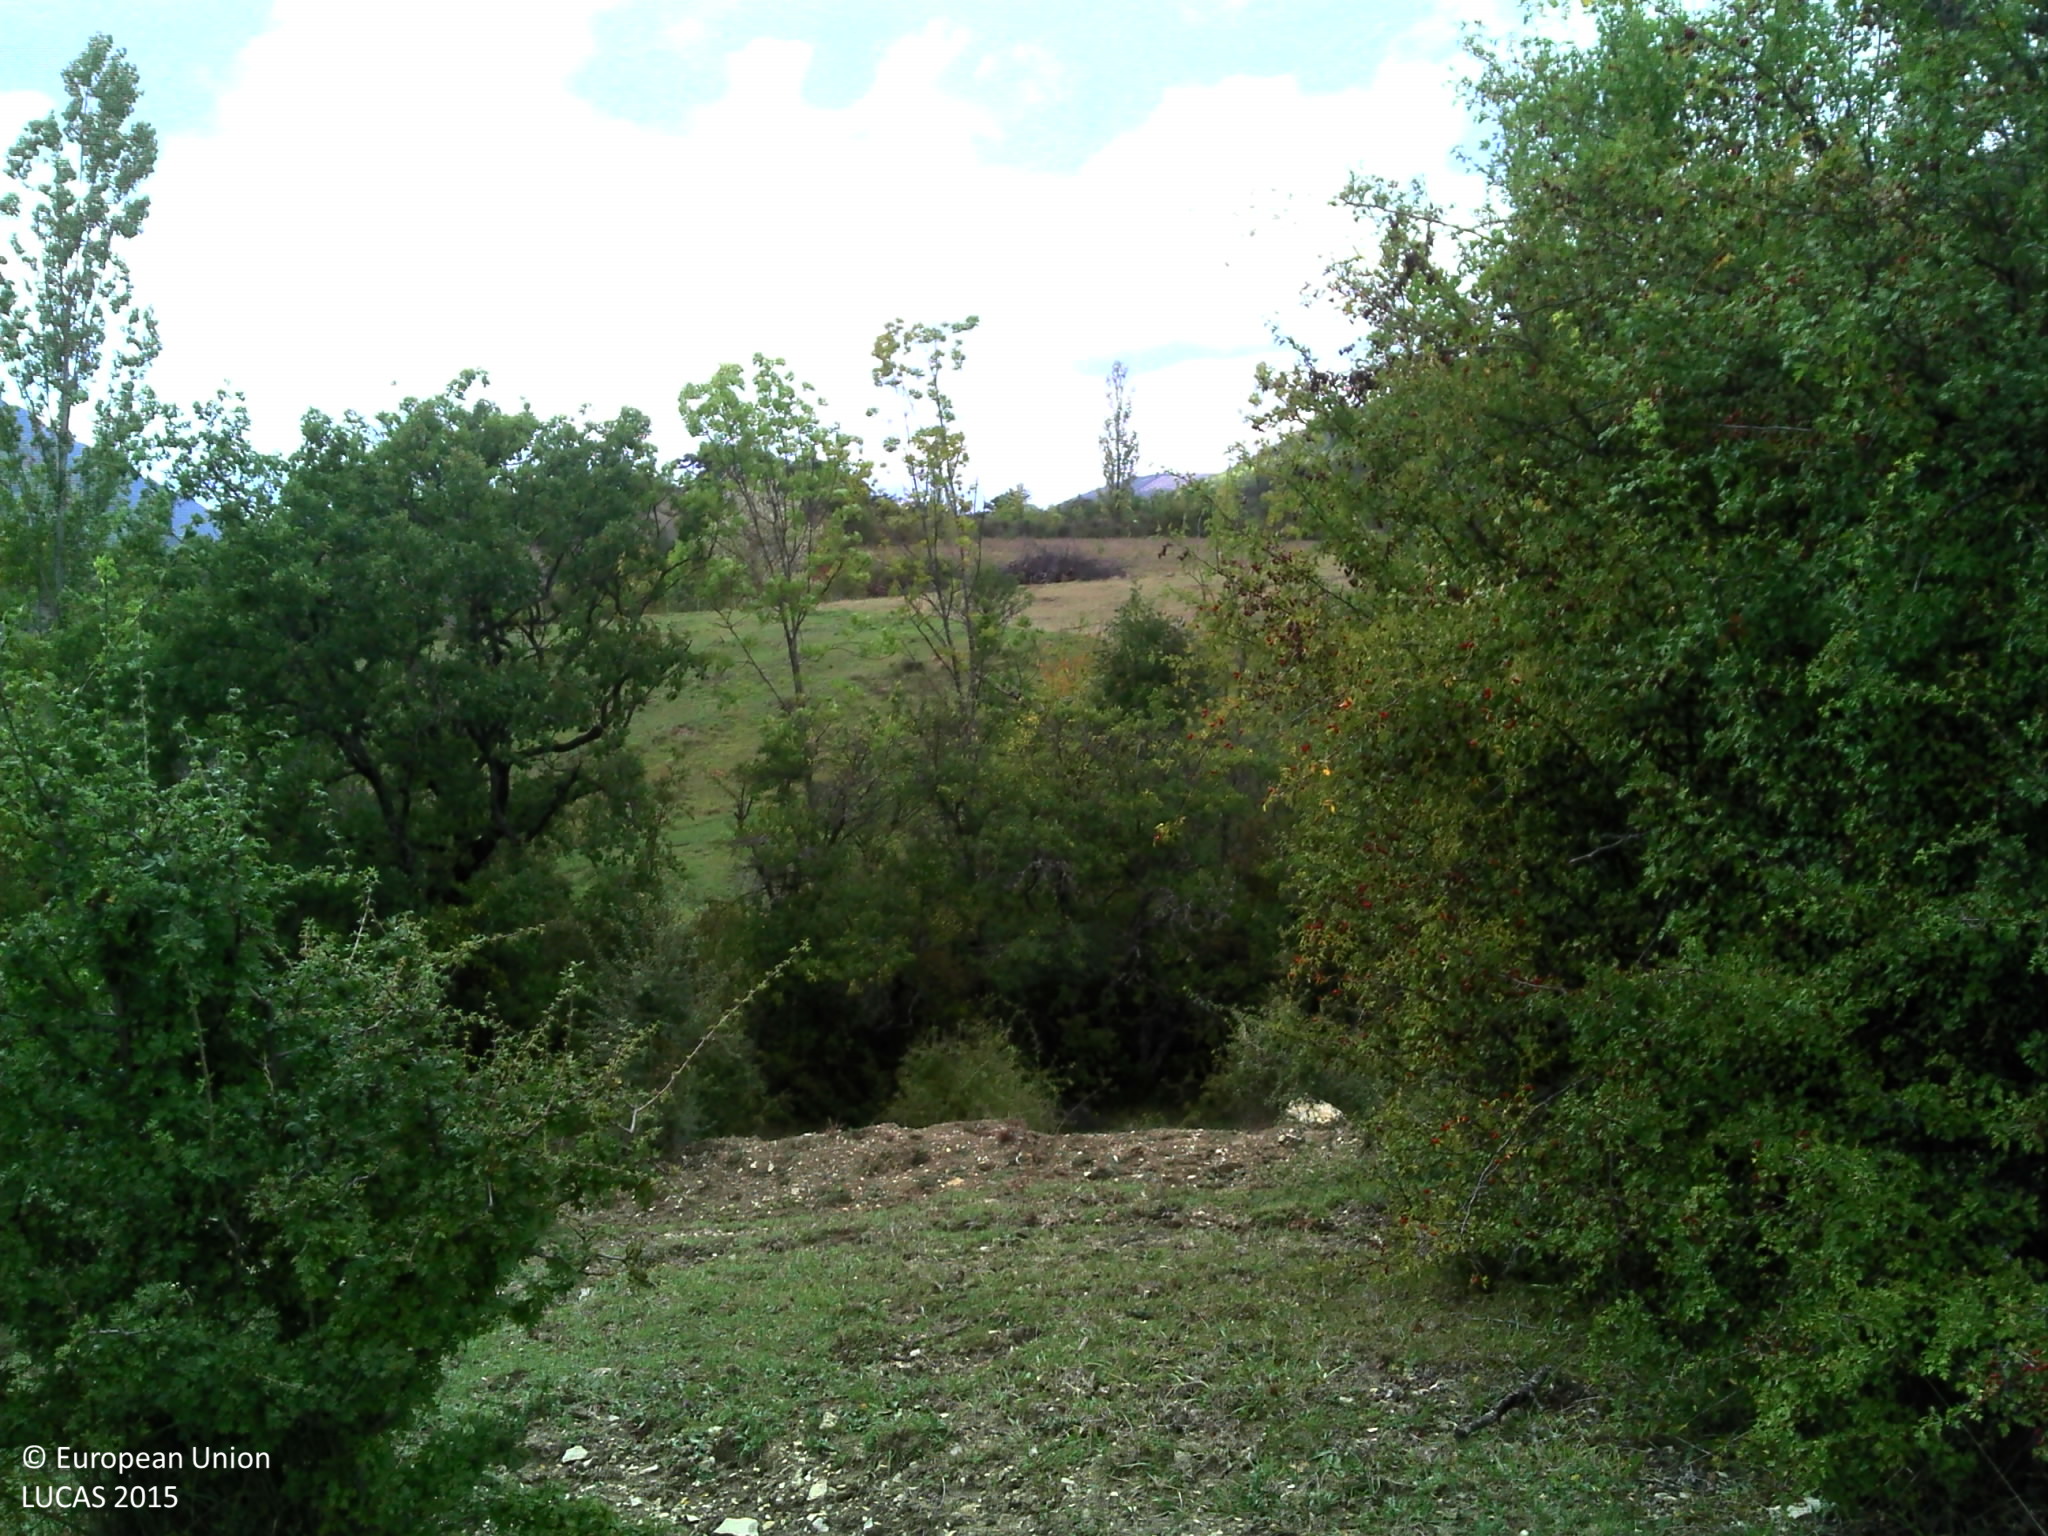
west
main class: Grassland
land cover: Grassland with sparse tree/shrub cover
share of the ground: > 75 %
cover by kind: herbaceous plants 85 %, shrubs 10 %, broadleaved forest trees 5 %
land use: Agriculture (excluding fallow land and kitchen gardens)
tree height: > 5 m
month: September
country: FR
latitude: 44.4695
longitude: 5.4943
